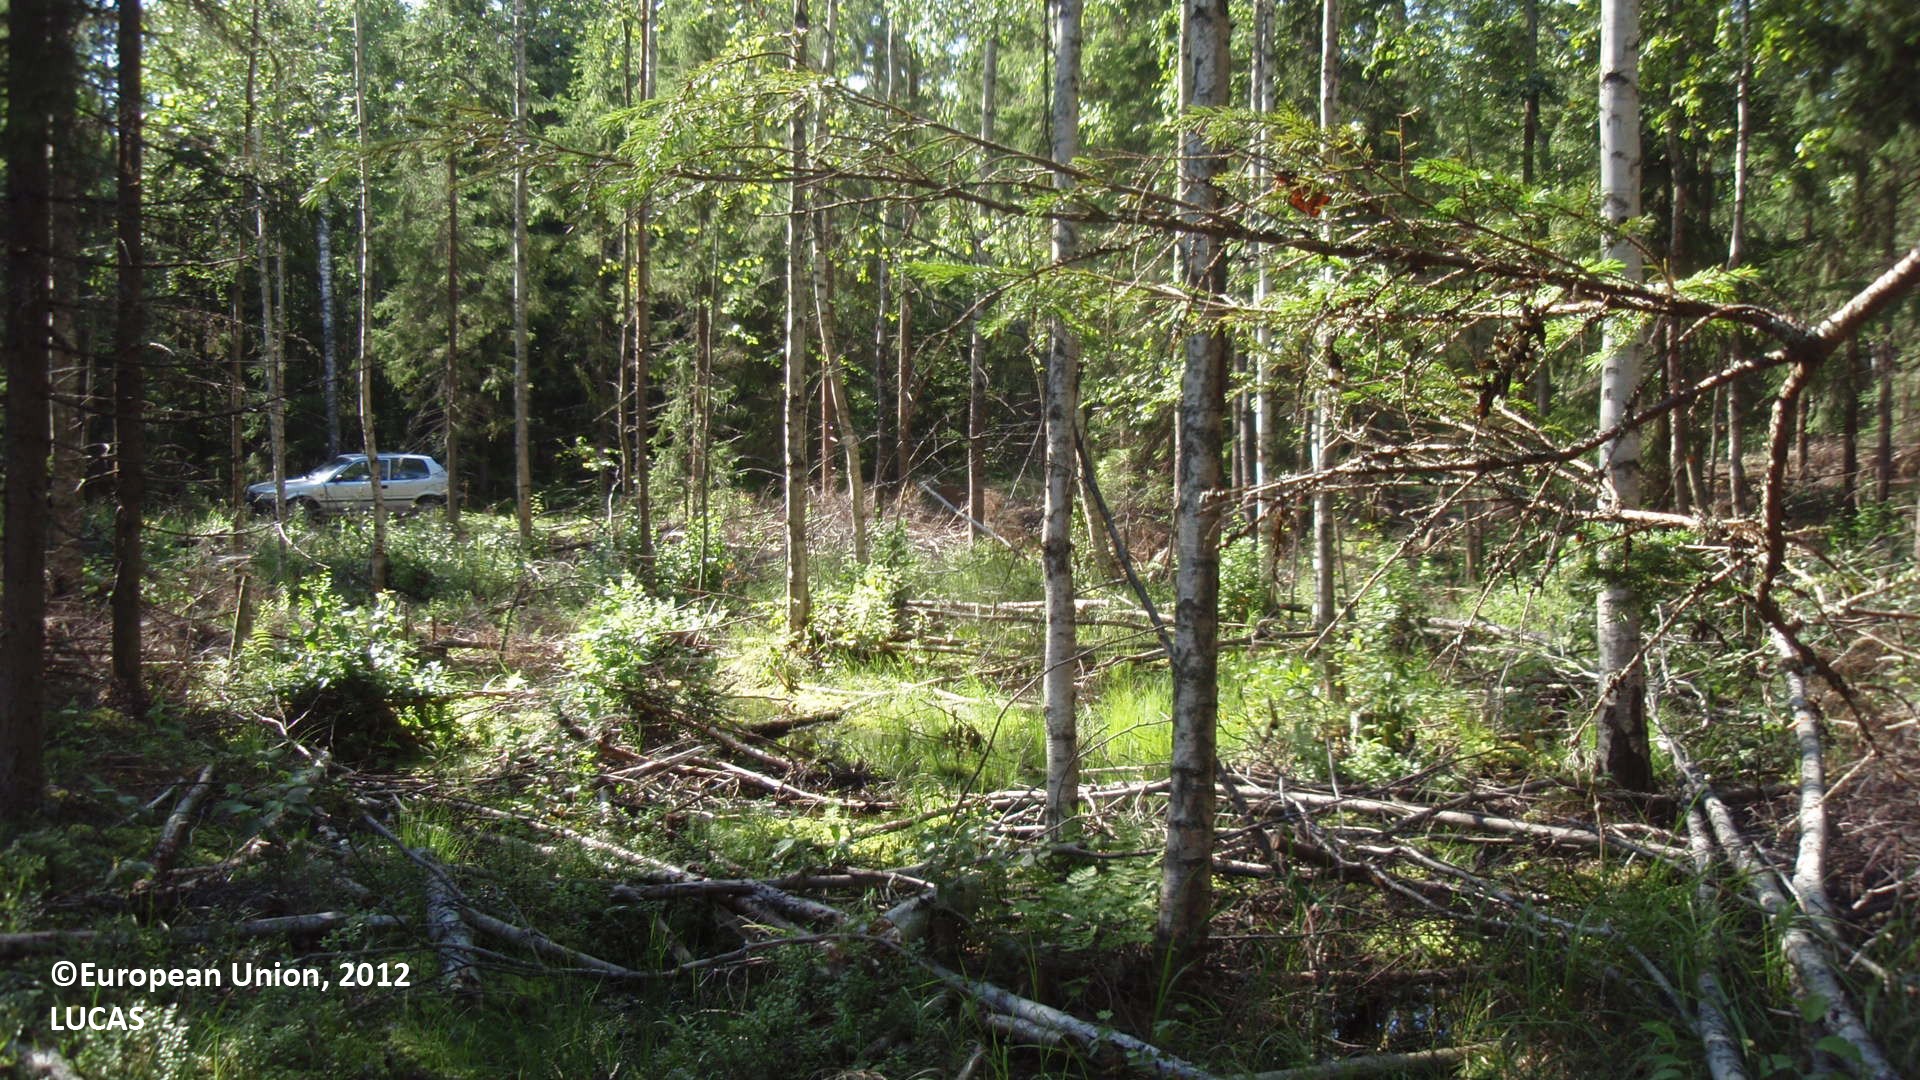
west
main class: Woodland
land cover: Spruce dominated mixed woodland
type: boreal forest
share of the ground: 25 - 50 %
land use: Forestry
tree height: > 5 m
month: July
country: FI
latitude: 61.1121
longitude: 28.2239
